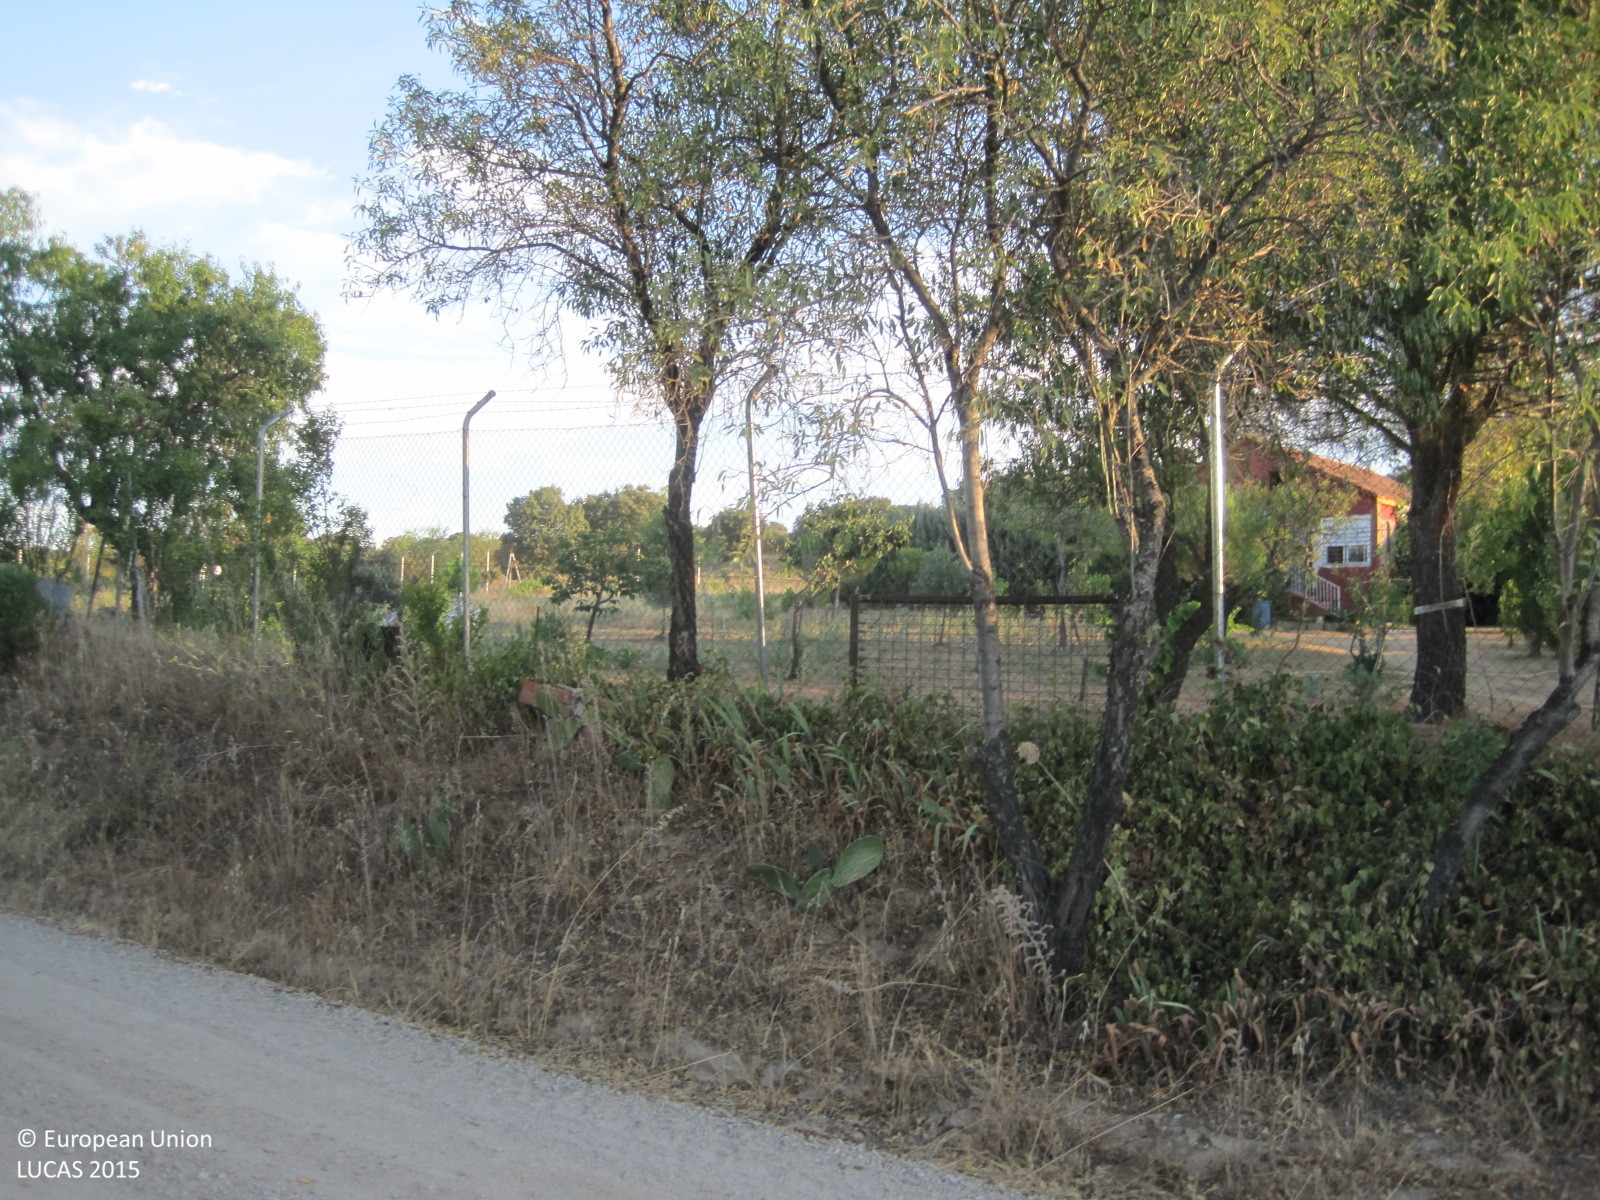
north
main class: Woodland
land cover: Pine dominated mixed woodland
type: coniferous forest of the mediterranean region
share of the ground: 50 - 75 %
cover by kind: coniferous forest trees 50 %, broadleaved forest trees 25 %, herbaceous plants 20 %, shrubs 5 %
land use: Semi-natural and natural areas not in use
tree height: > 5 m
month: July
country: ES
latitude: 40.3613
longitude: -4.3533
